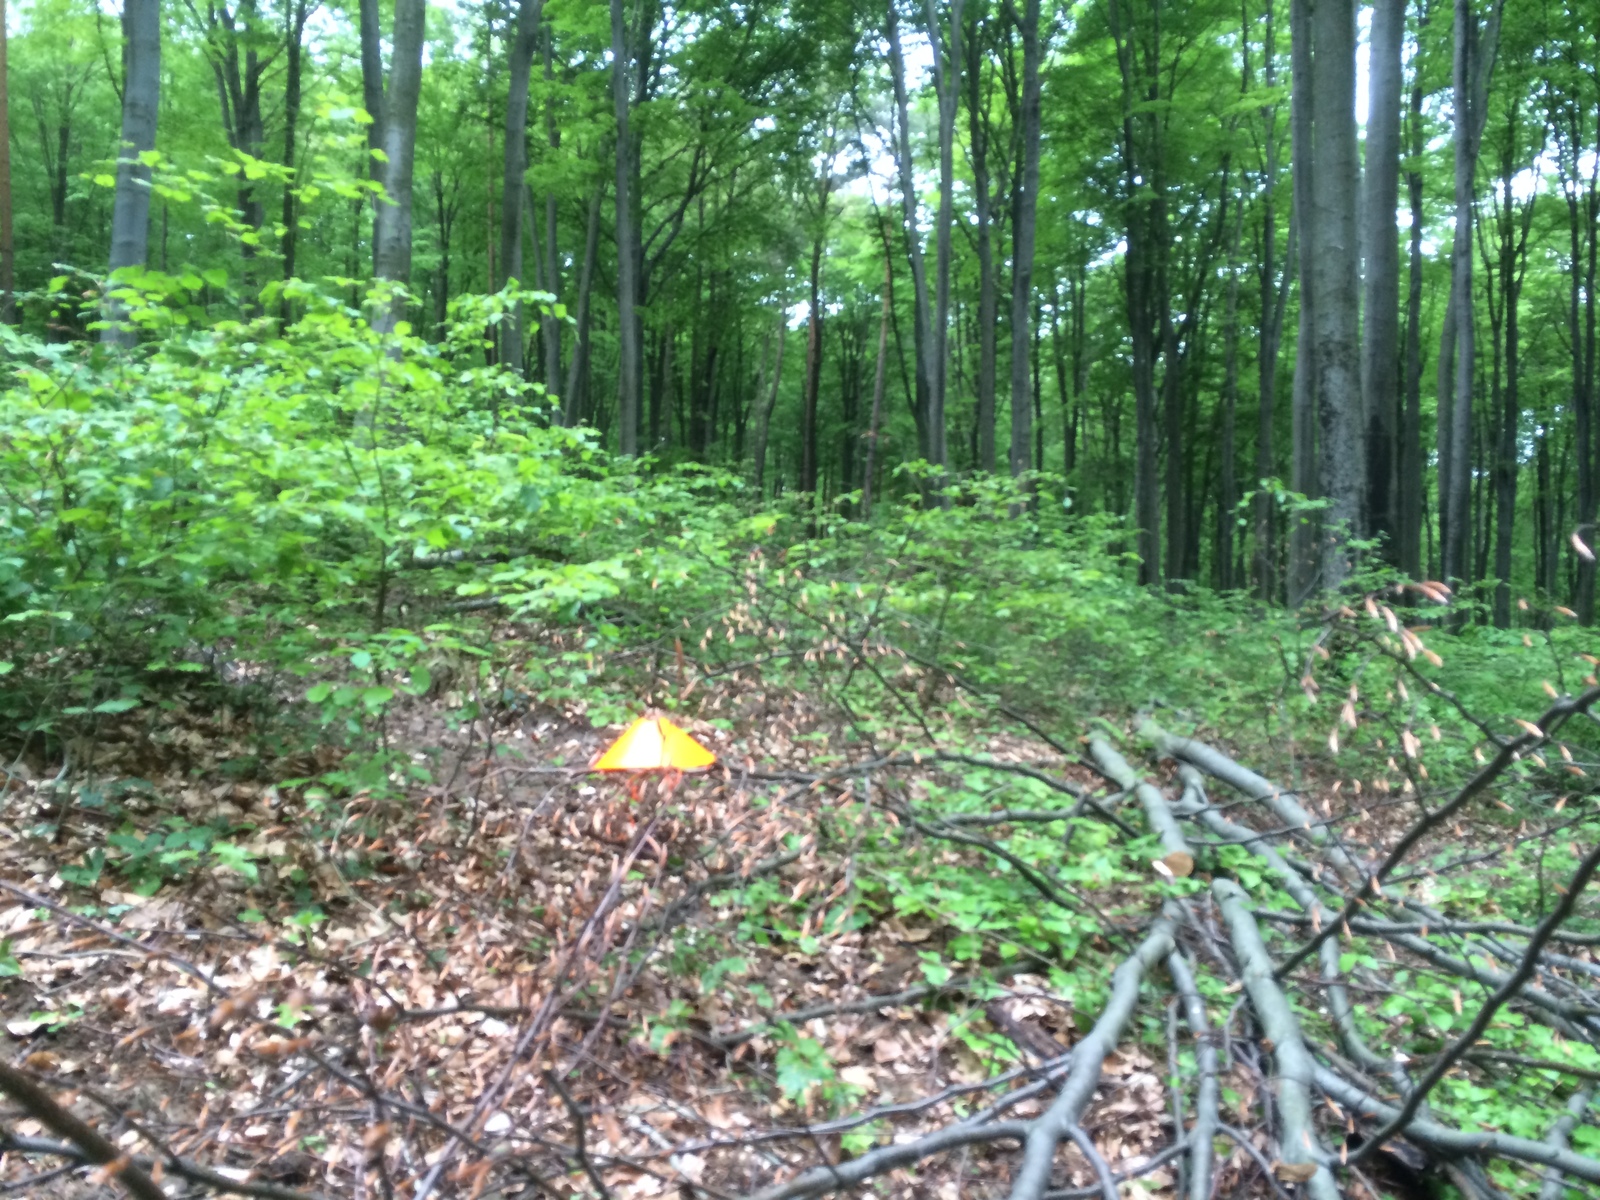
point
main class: Woodland
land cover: Broadleaved woodland
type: beech forest
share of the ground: > 75 %
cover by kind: broadleaved forest trees 100 %
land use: Forestry
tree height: > 5 m
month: May
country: AT
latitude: 48.0497
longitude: 16.1885
